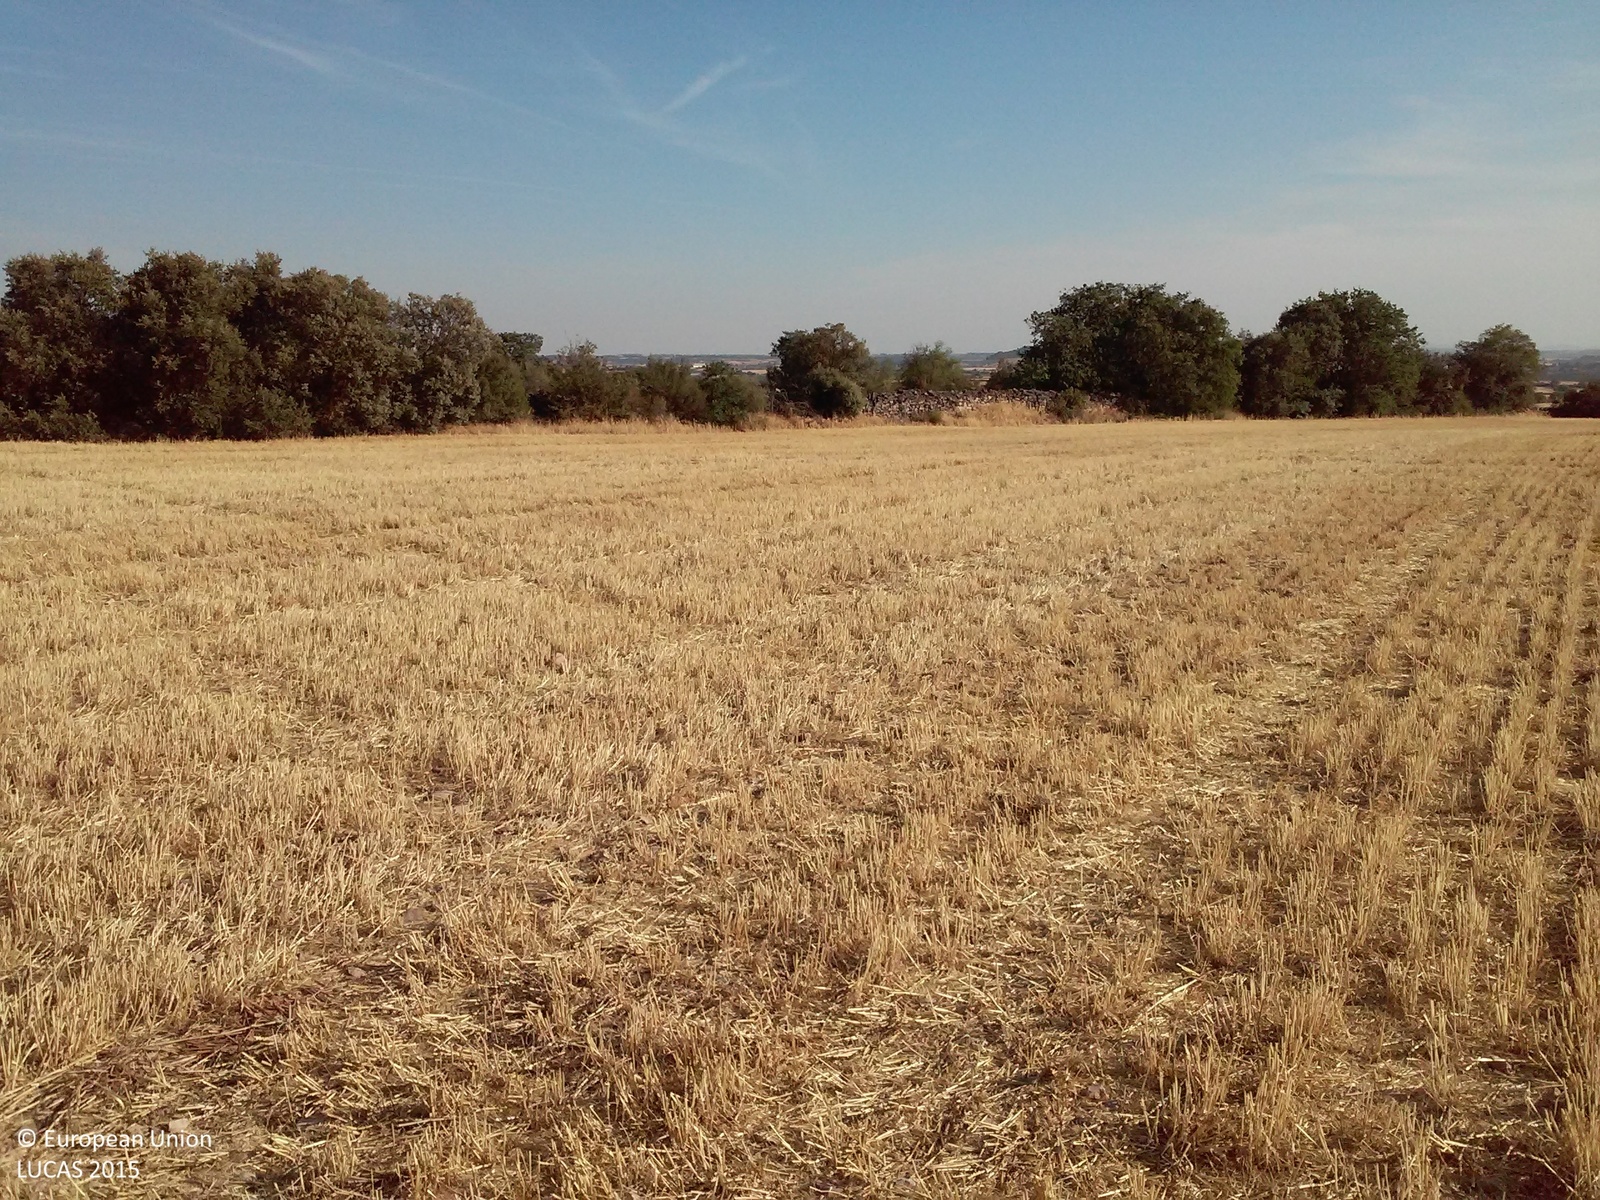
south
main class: Cropland
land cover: Barley
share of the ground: < 10 %
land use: Agriculture (excluding fallow land and kitchen gardens)
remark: Harvested field
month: July
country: ES
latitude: 41.6138
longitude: 1.1695
